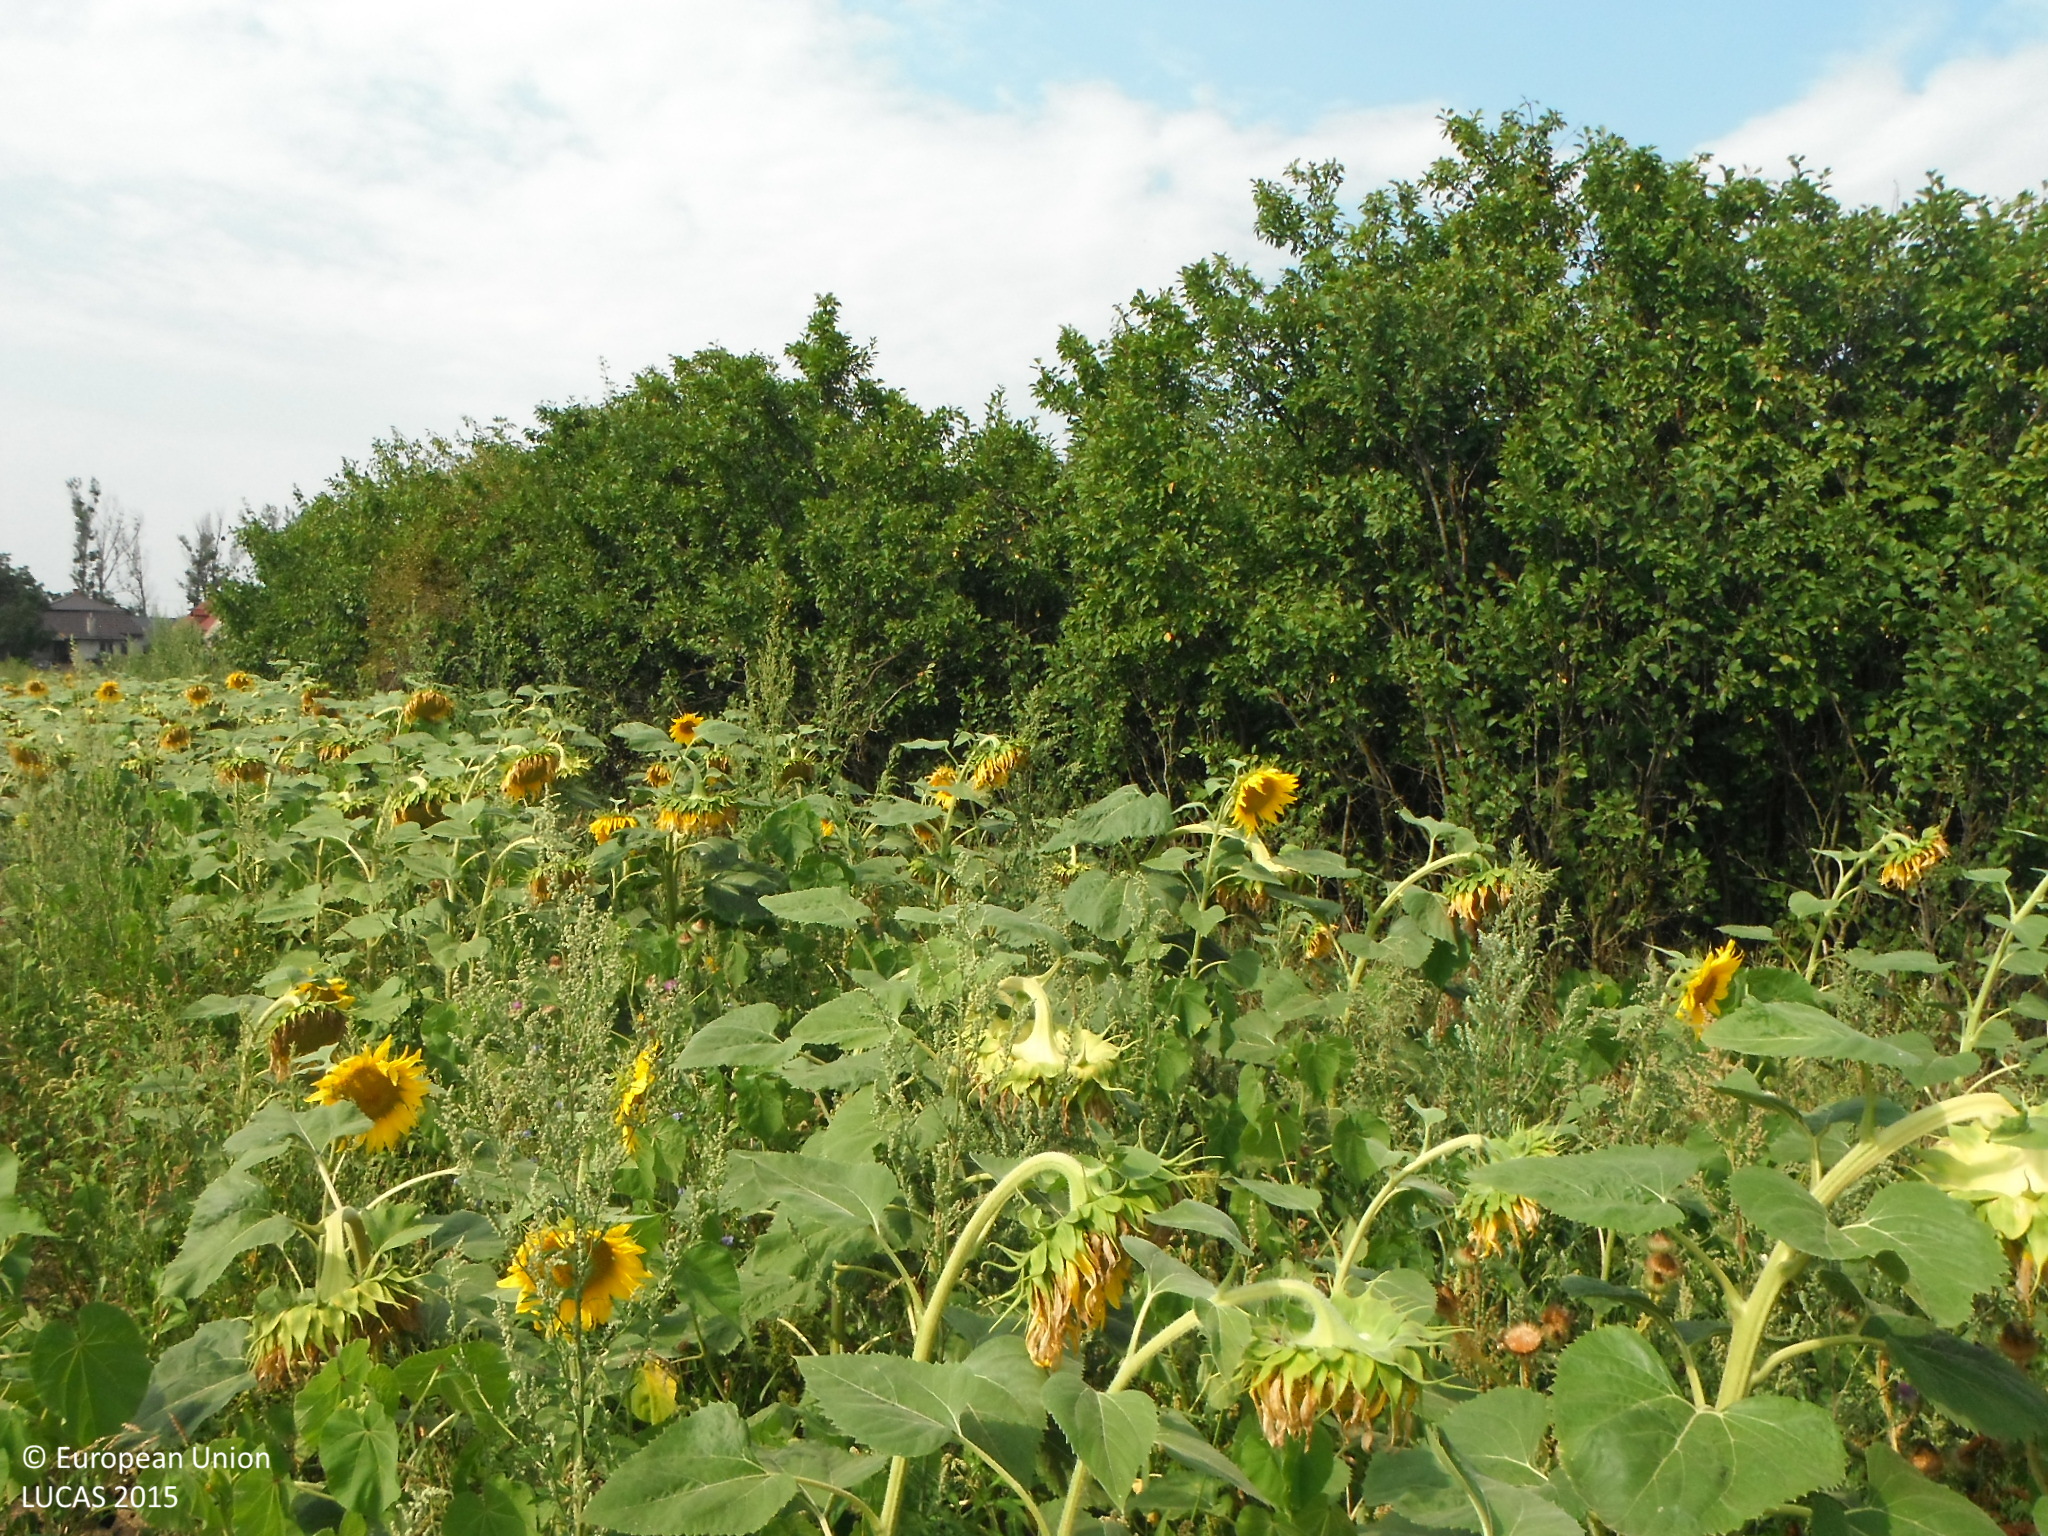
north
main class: Cropland
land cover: Sunflower
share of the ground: > 75 %
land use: Agriculture (excluding fallow land and kitchen gardens)
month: August
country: SK
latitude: 48.4591
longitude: 21.6379
